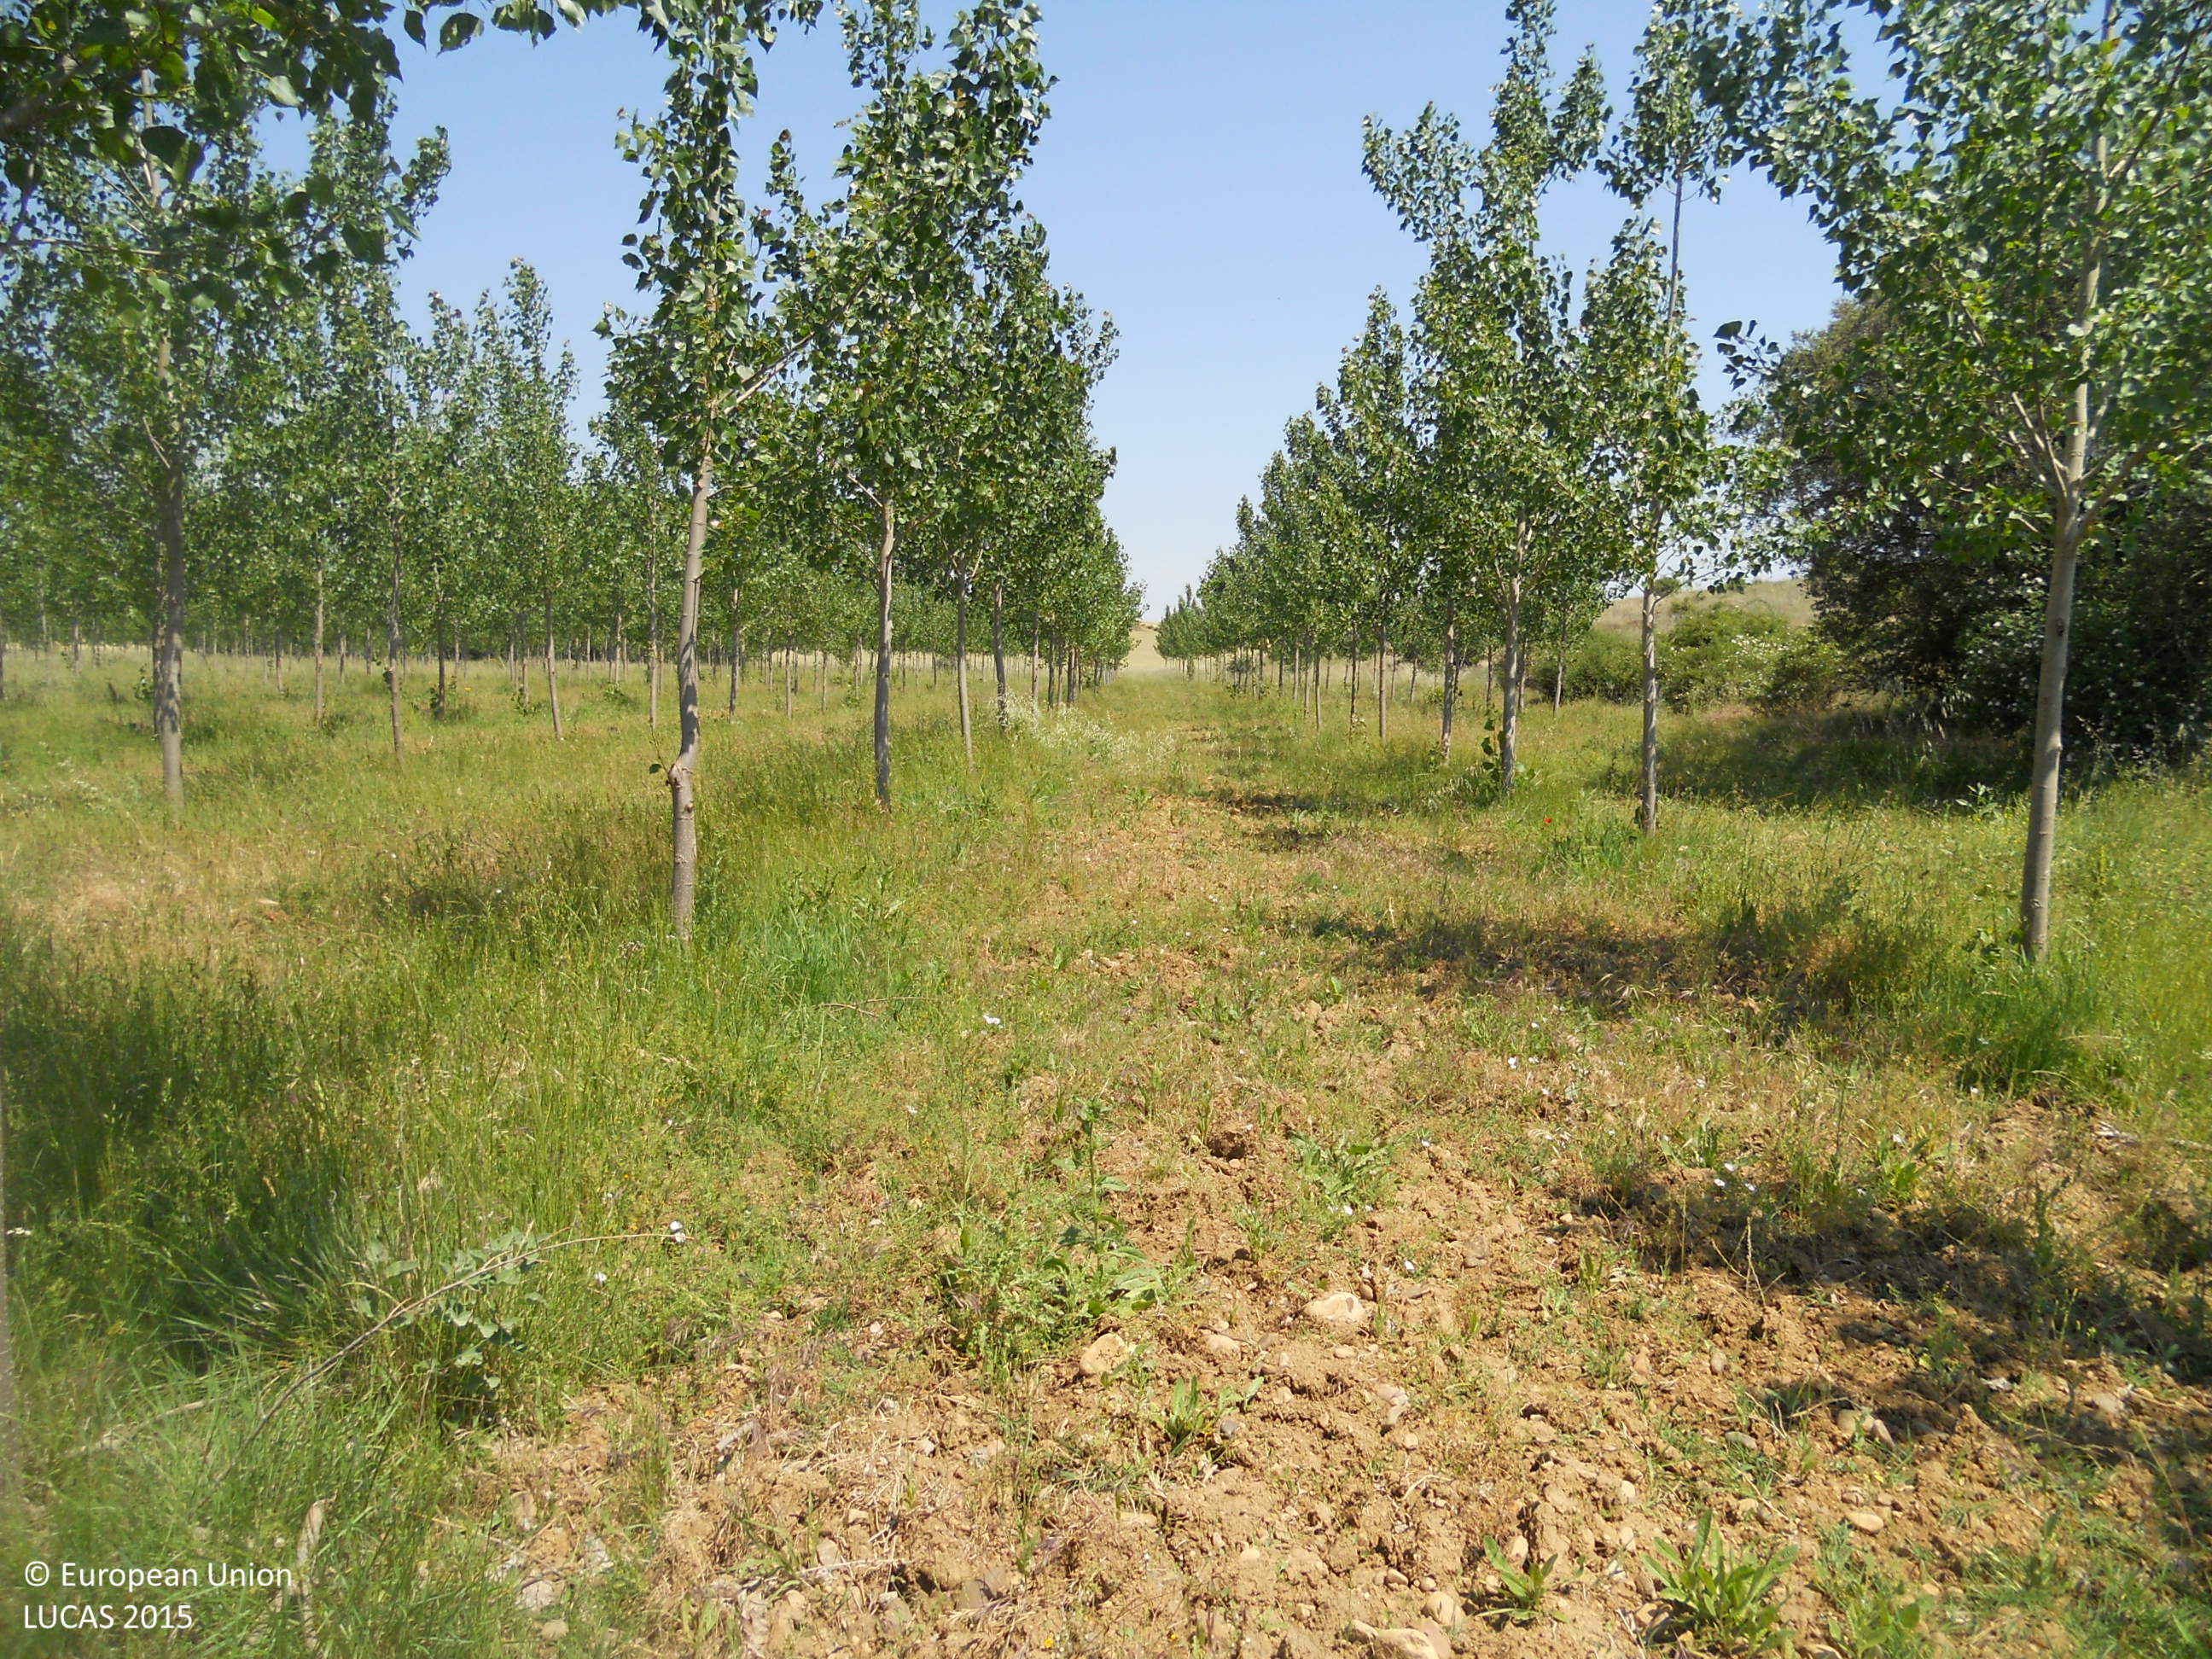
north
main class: Woodland
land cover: Broadleaved woodland
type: exotic forest
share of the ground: 10 - 25 %
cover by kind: herbaceous plants 75 %, broadleaved forest trees 20 %, shrubs 5 %
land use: Forestry
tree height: < 5 m
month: June
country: ES
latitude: 42.1977
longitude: -5.3096
